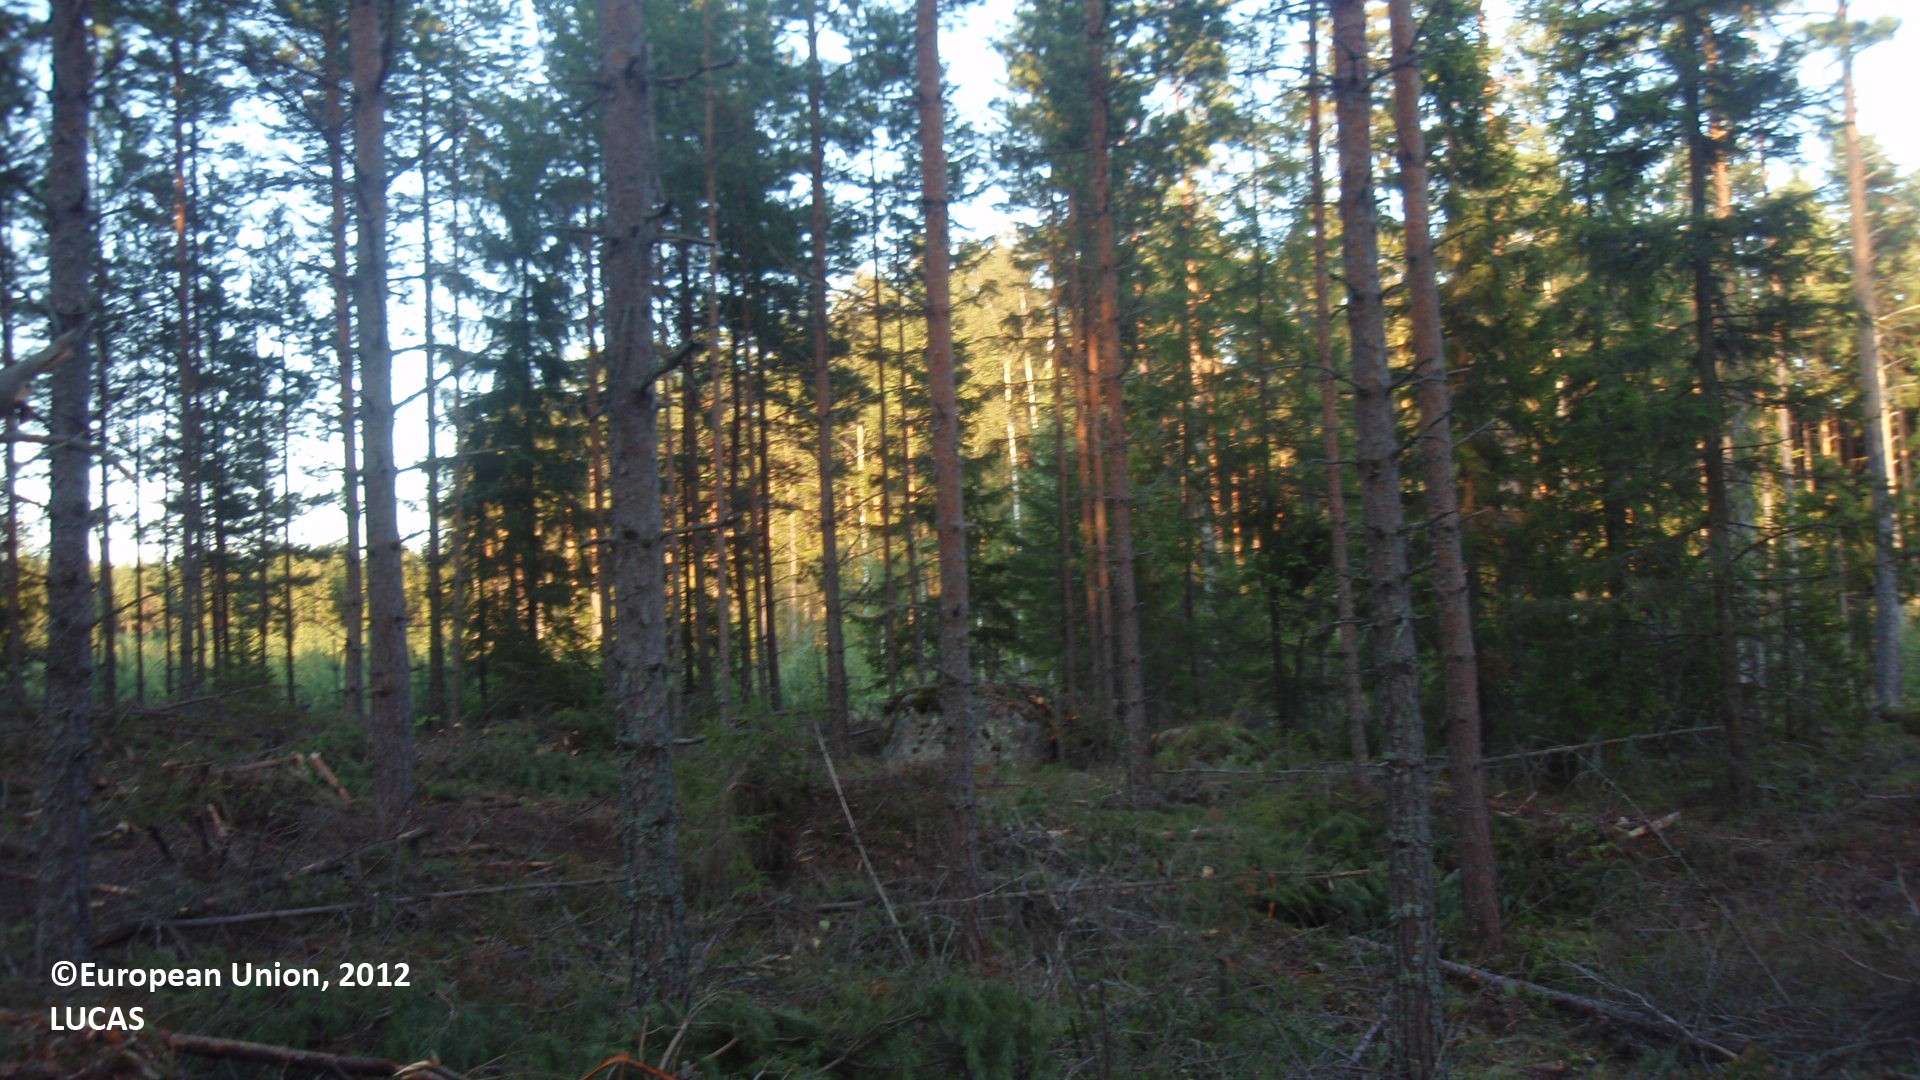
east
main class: Woodland
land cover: Pine dominated coniferous woodland
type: boreal forest
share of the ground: 50 - 75 %
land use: Forestry
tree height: > 5 m
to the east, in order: Pine dominated coniferous woodland; Shrubland with sparse tree cover; Pine dominated mixed woodland; Spruce dominated coniferous woodland; Paved roads, cycling and walking lanes; Pine dominated coniferous woodland
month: August
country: FI
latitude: 60.5292
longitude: 27.4029
